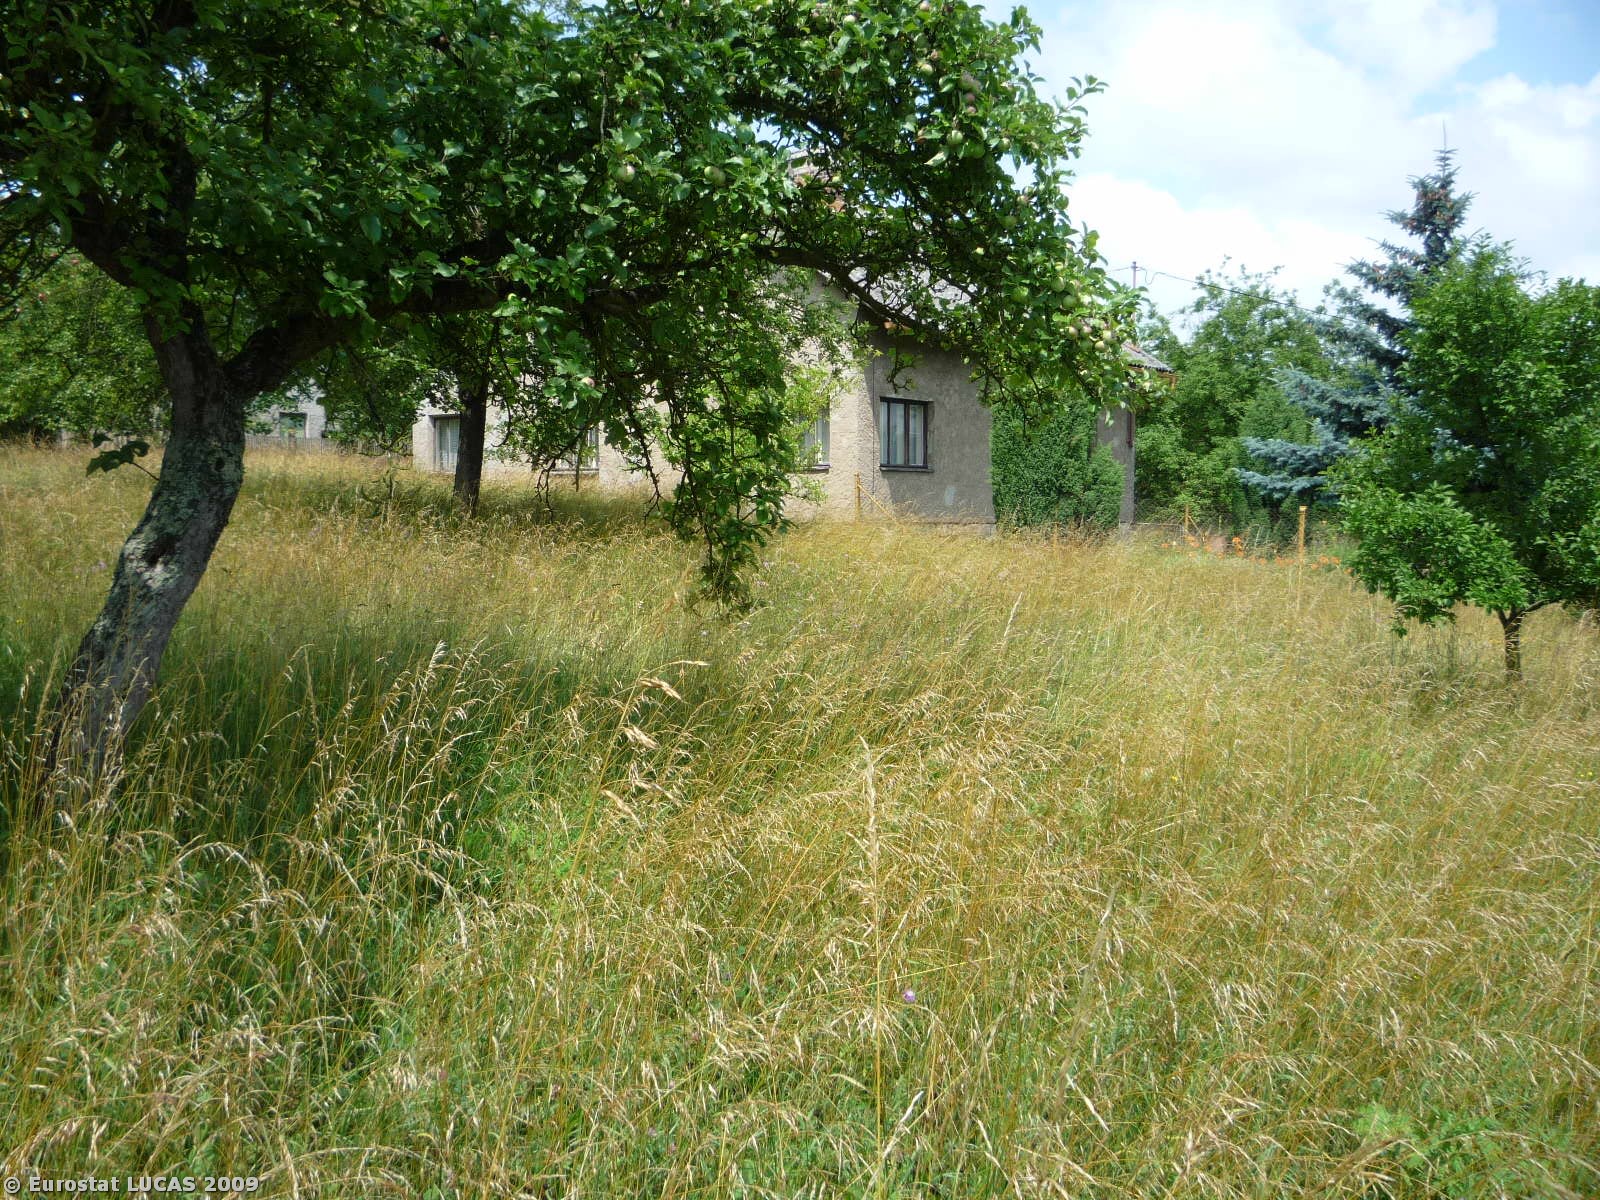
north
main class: Cropland
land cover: Apple fruit
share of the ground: 10 - 25 %
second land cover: Grassland with sparse tree/shrub cover
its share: > 75 %
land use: Agriculture (excluding fallow land and kitchen gardens)
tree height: > 5 m
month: June
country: CZ
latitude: 50.1442
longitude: 15.4472
